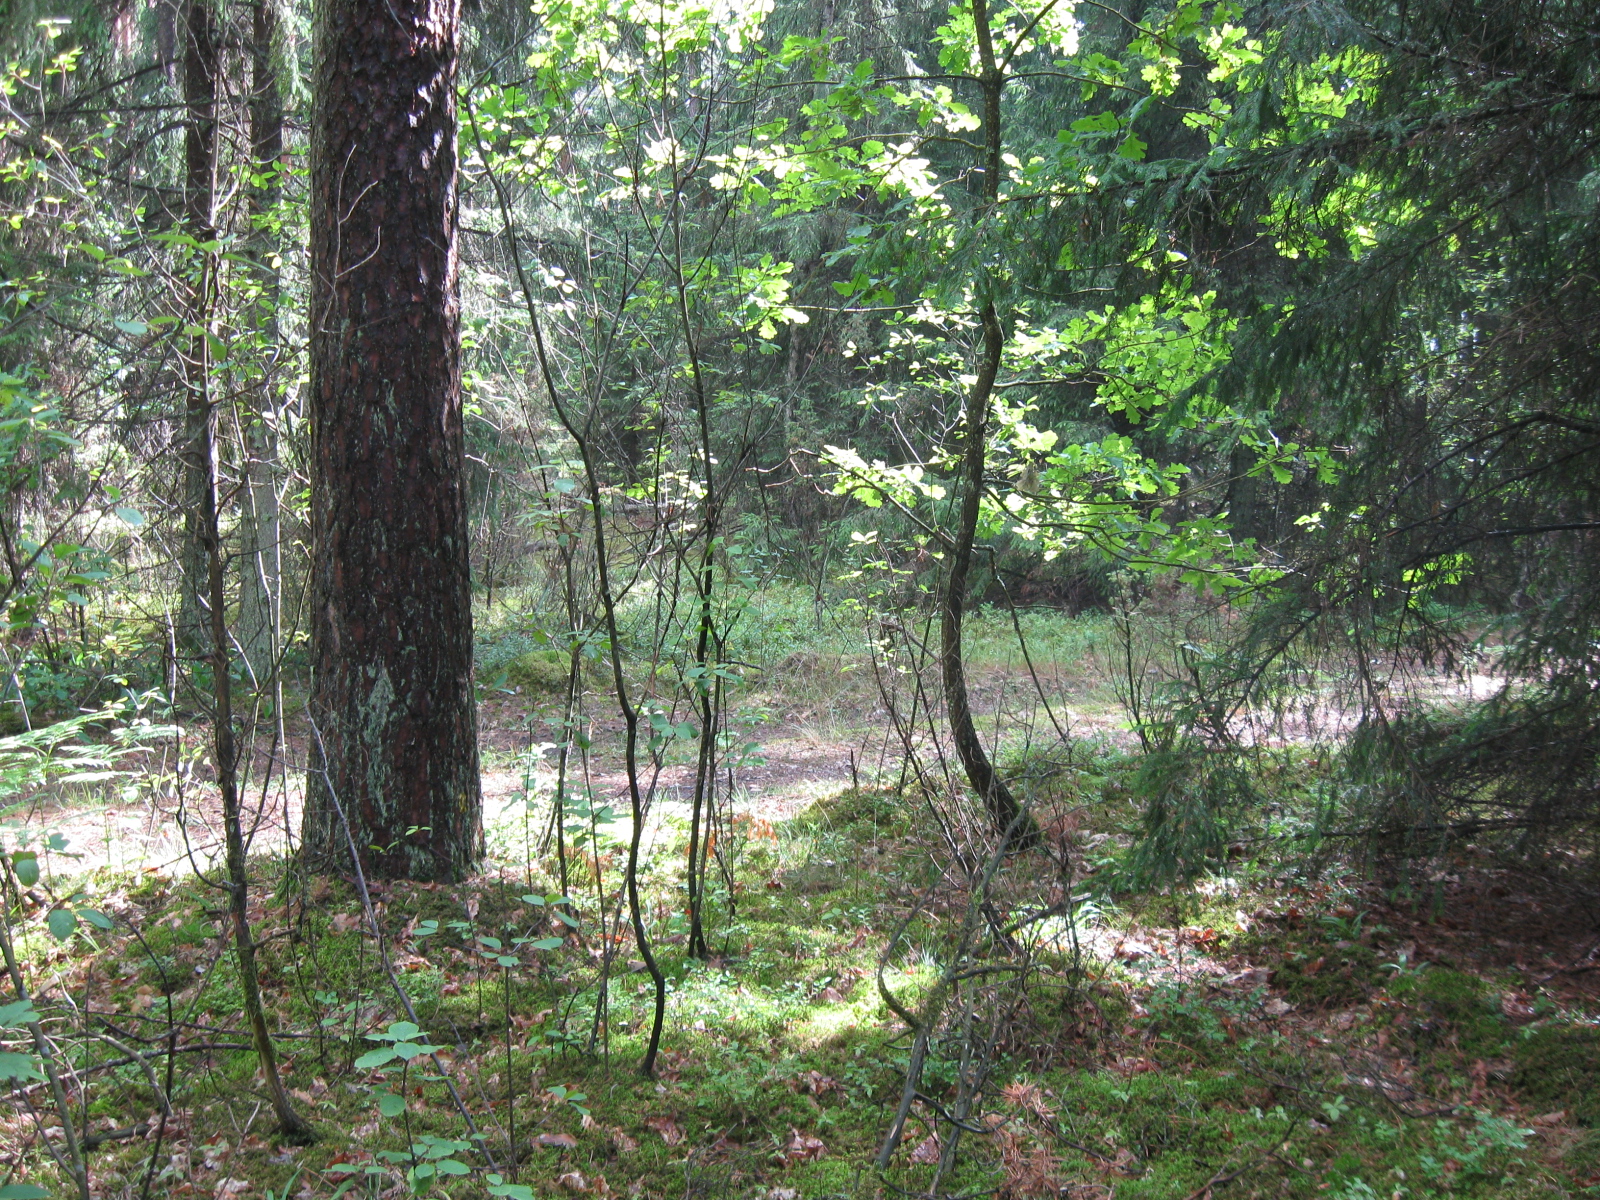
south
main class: Woodland
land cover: Other coniferous woodland
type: hemiboreal forest and nemoral coniferous forest and mixed broadleaved-coniferous forest
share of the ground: > 75 %
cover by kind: coniferous forest trees 80 %, lichens and mosses 10 %, broadleaved forest trees 5 %, herbaceous plants 5 %
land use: Forestry
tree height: > 5 m
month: July
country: LT
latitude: 53.9582
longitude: 23.6343
